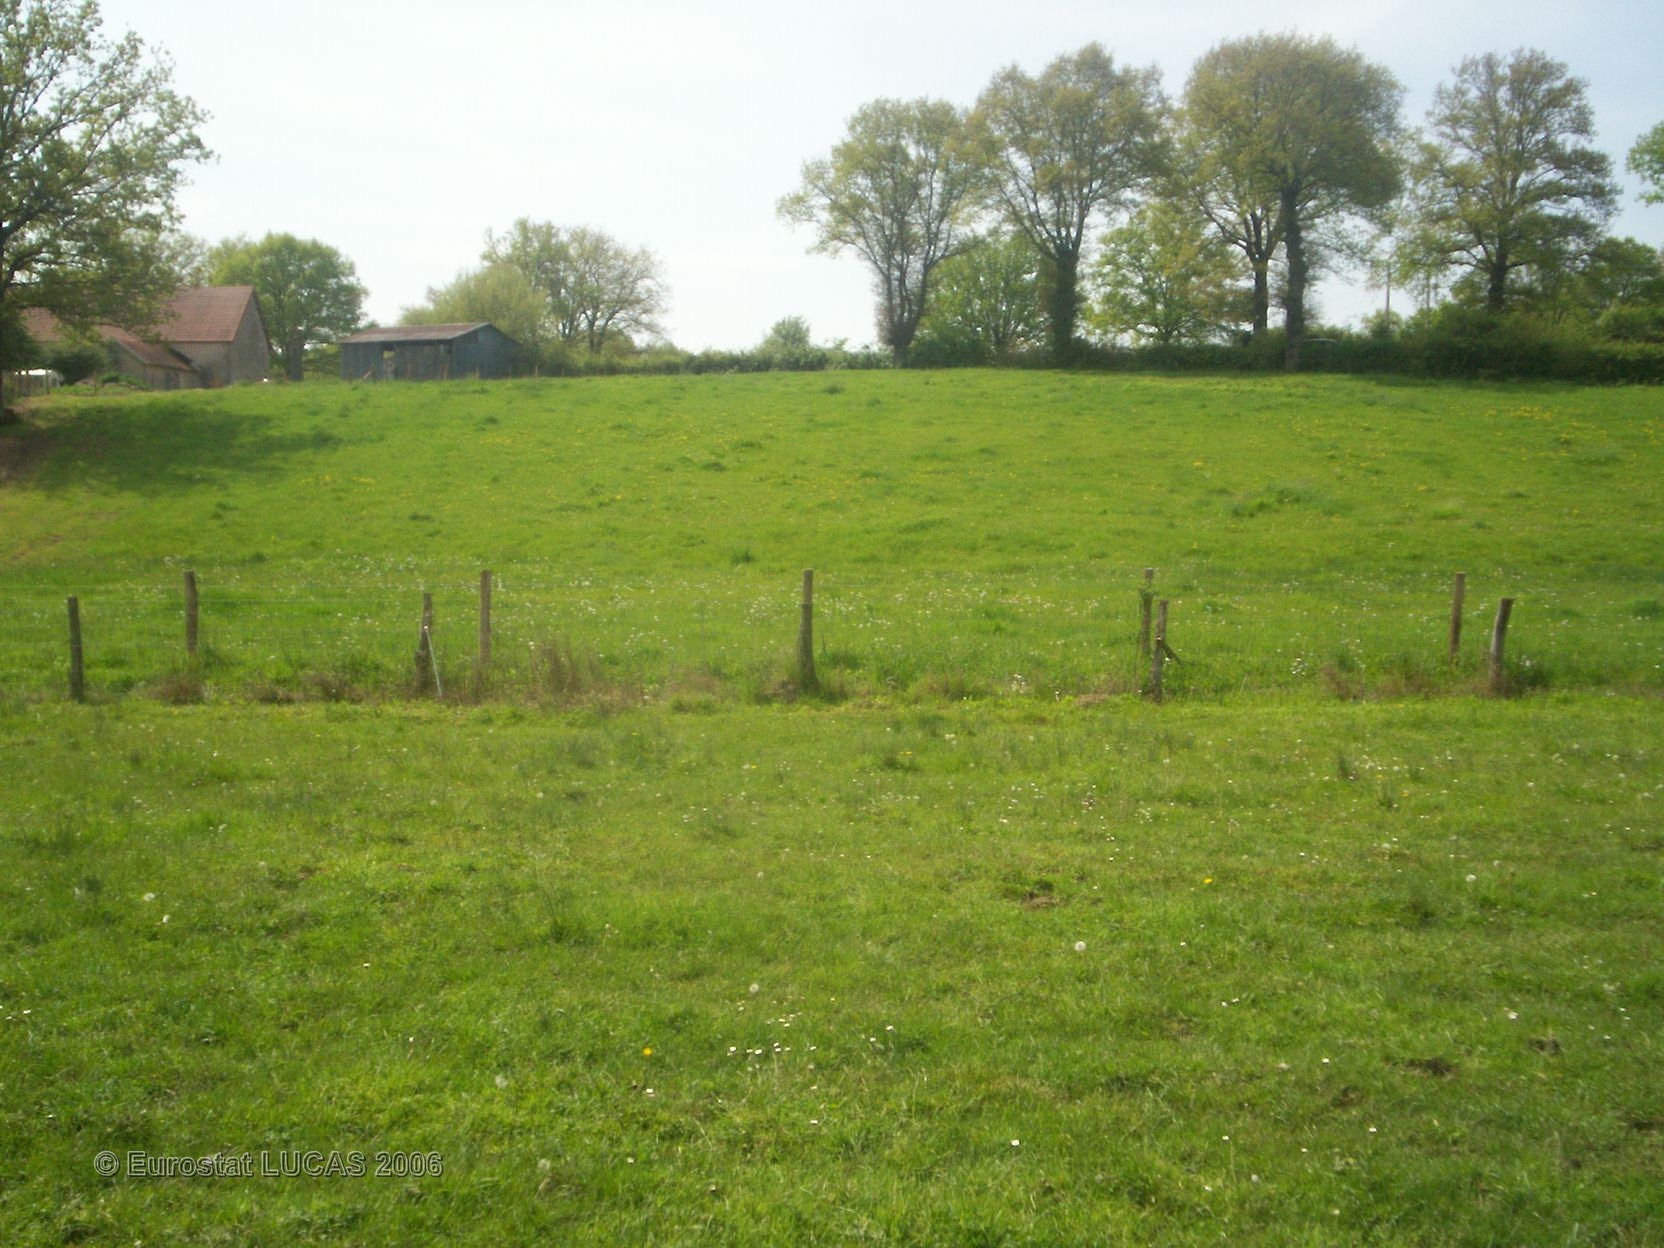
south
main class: Grassland
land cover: Grassland without tree/shrub cover
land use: Agriculture (excluding fallow land and kitchen gardens)
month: May
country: FR
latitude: 46.5439
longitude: 3.0988
